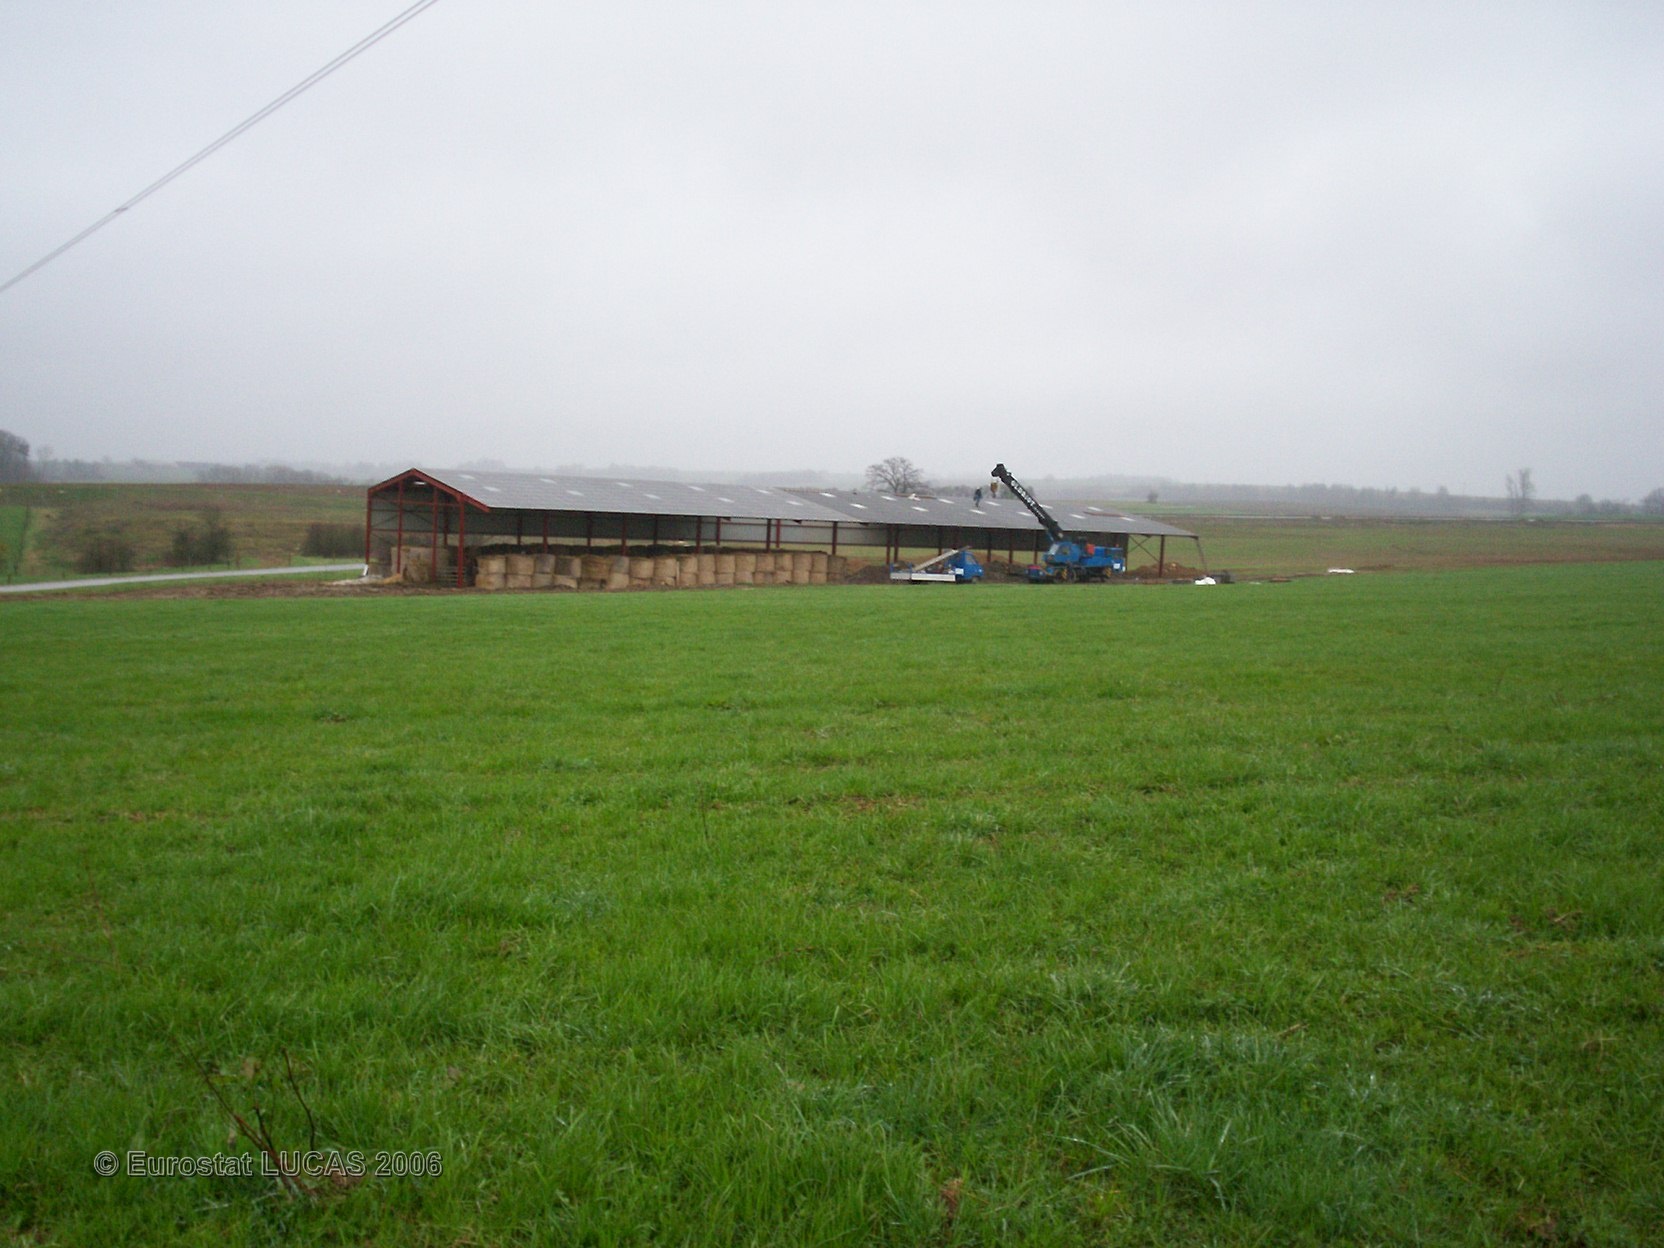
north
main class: Grassland
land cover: Grassland without tree/shrub cover
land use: Agriculture (excluding fallow land and kitchen gardens)
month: April
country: FR
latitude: 48.5917
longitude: 6.8144
